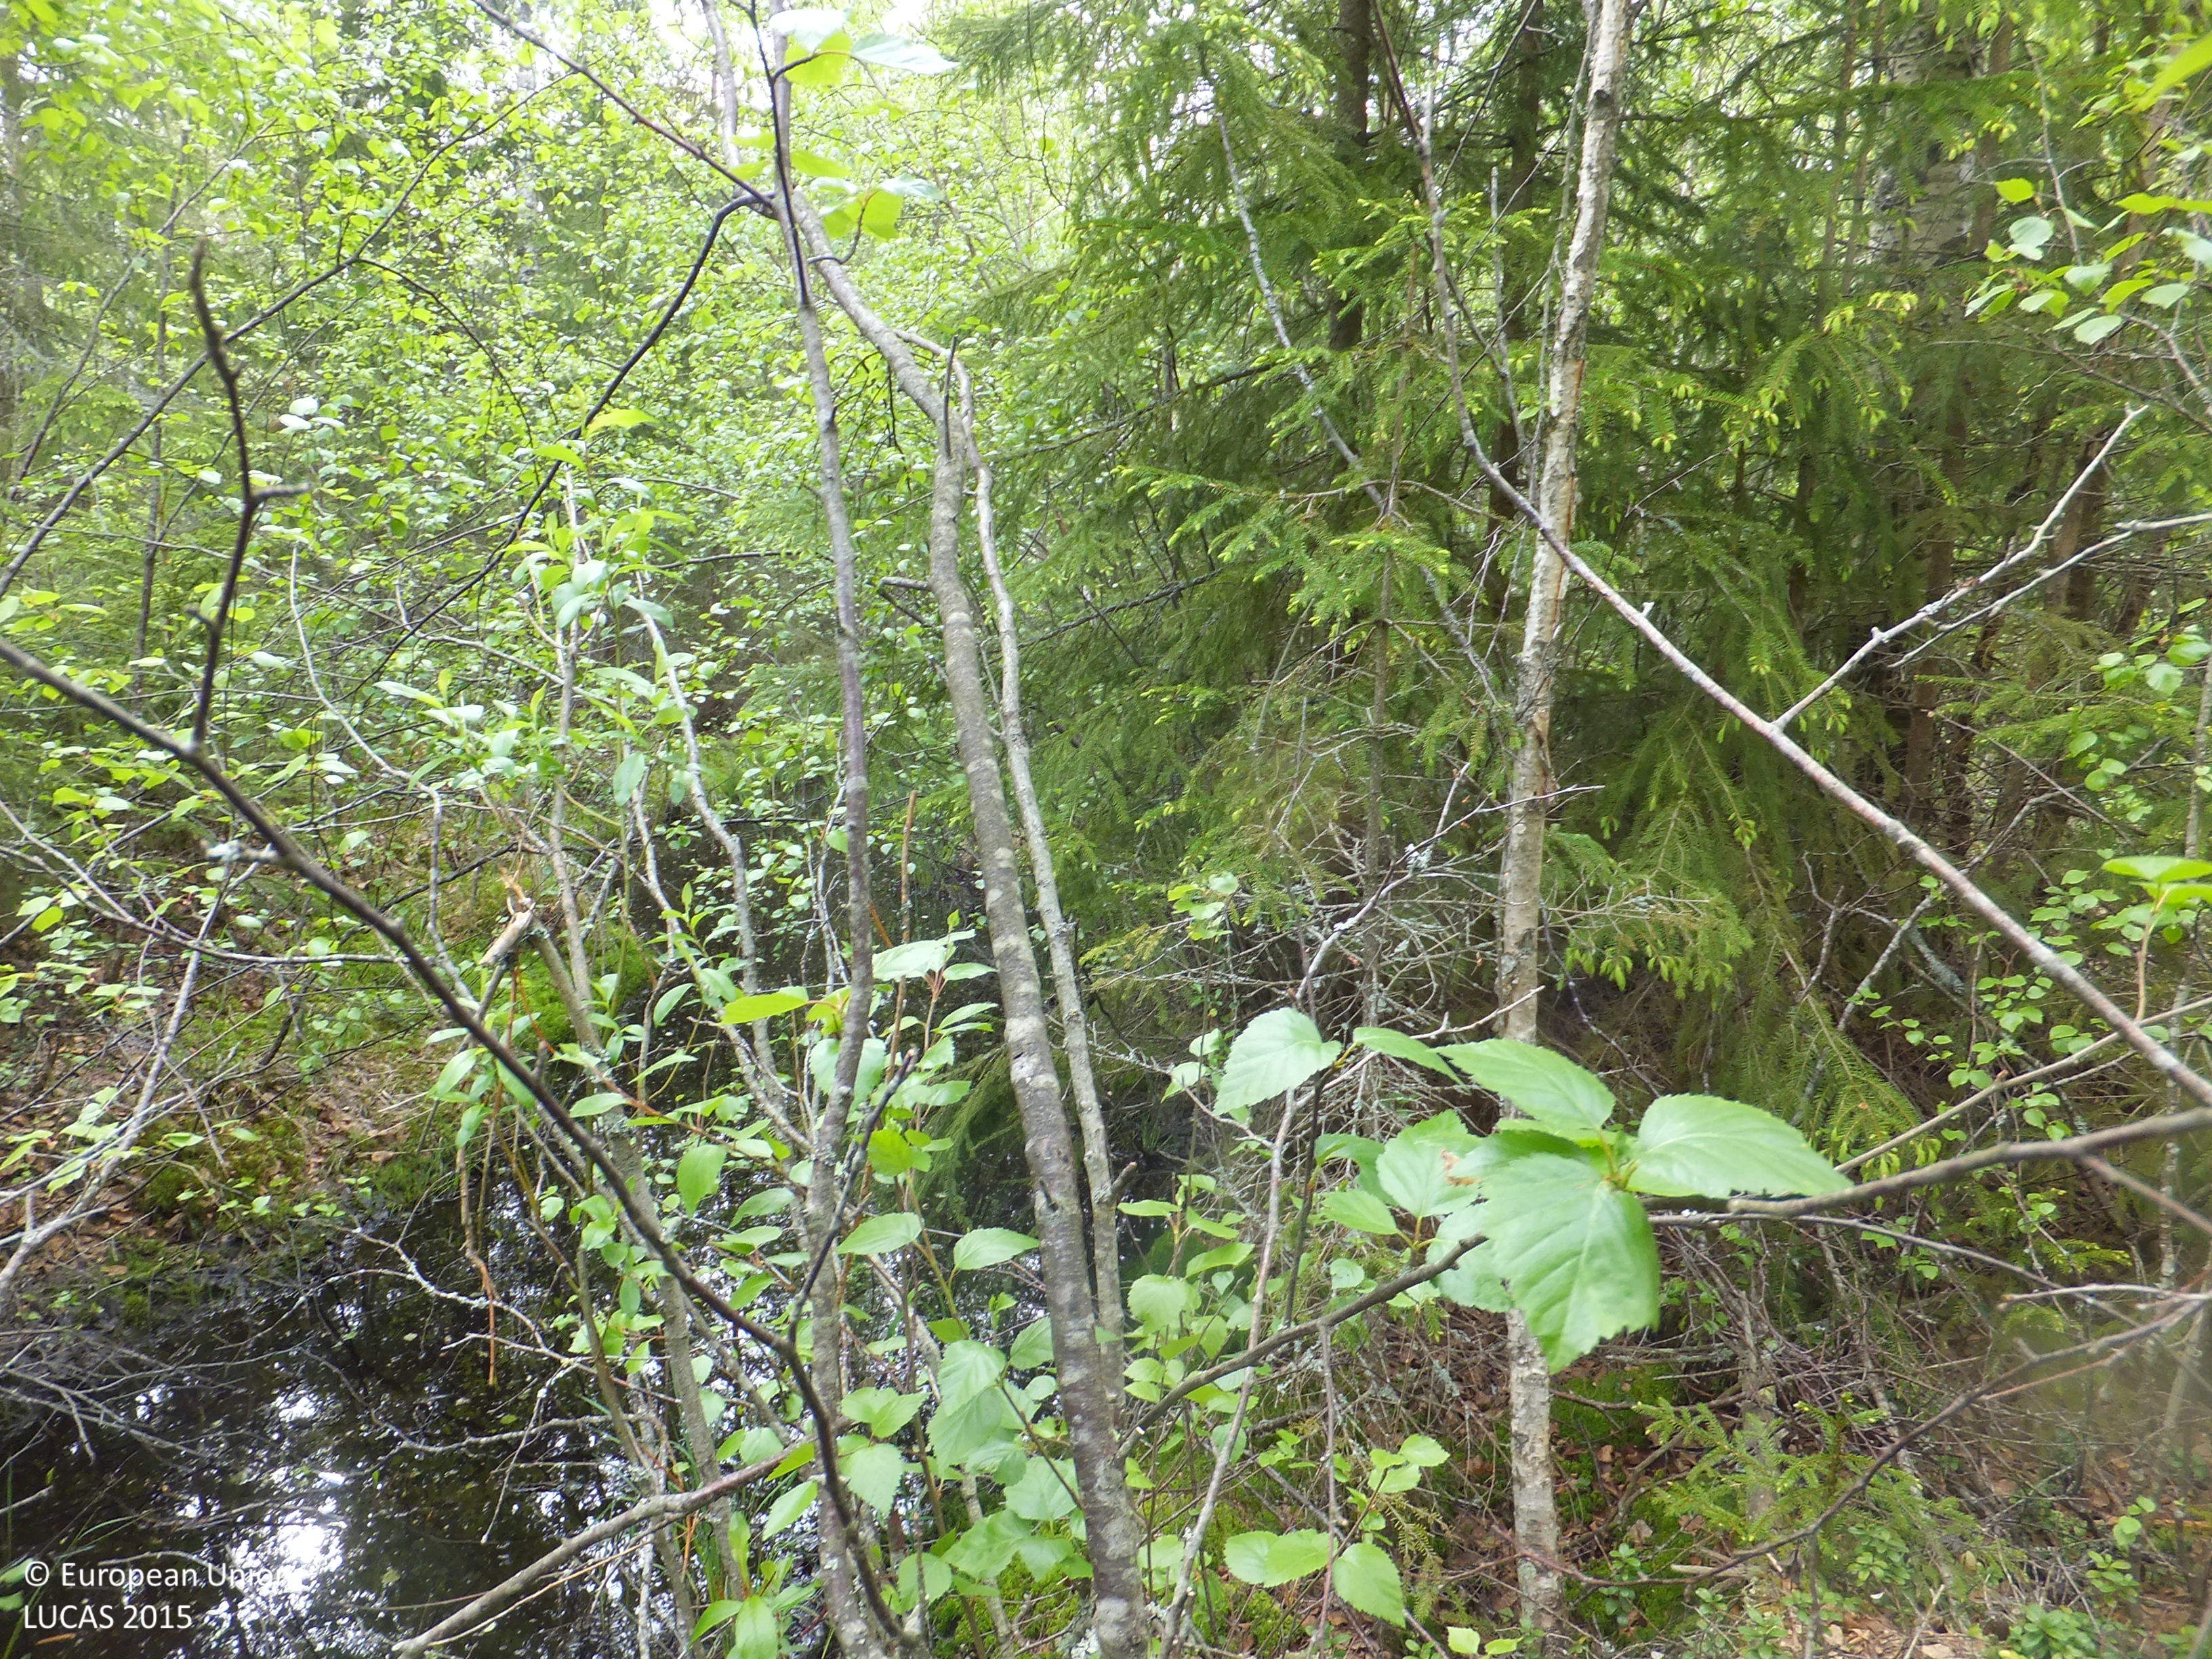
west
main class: Woodland
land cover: Spruce dominated mixed woodland
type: boreal forest
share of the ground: 50 - 75 %
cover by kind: broadleaved forest trees 50 %, shrubs 30 %, coniferous forest trees 20 %
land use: Forestry
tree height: > 5 m
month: June
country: FI
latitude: 63.5129
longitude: 22.3240
